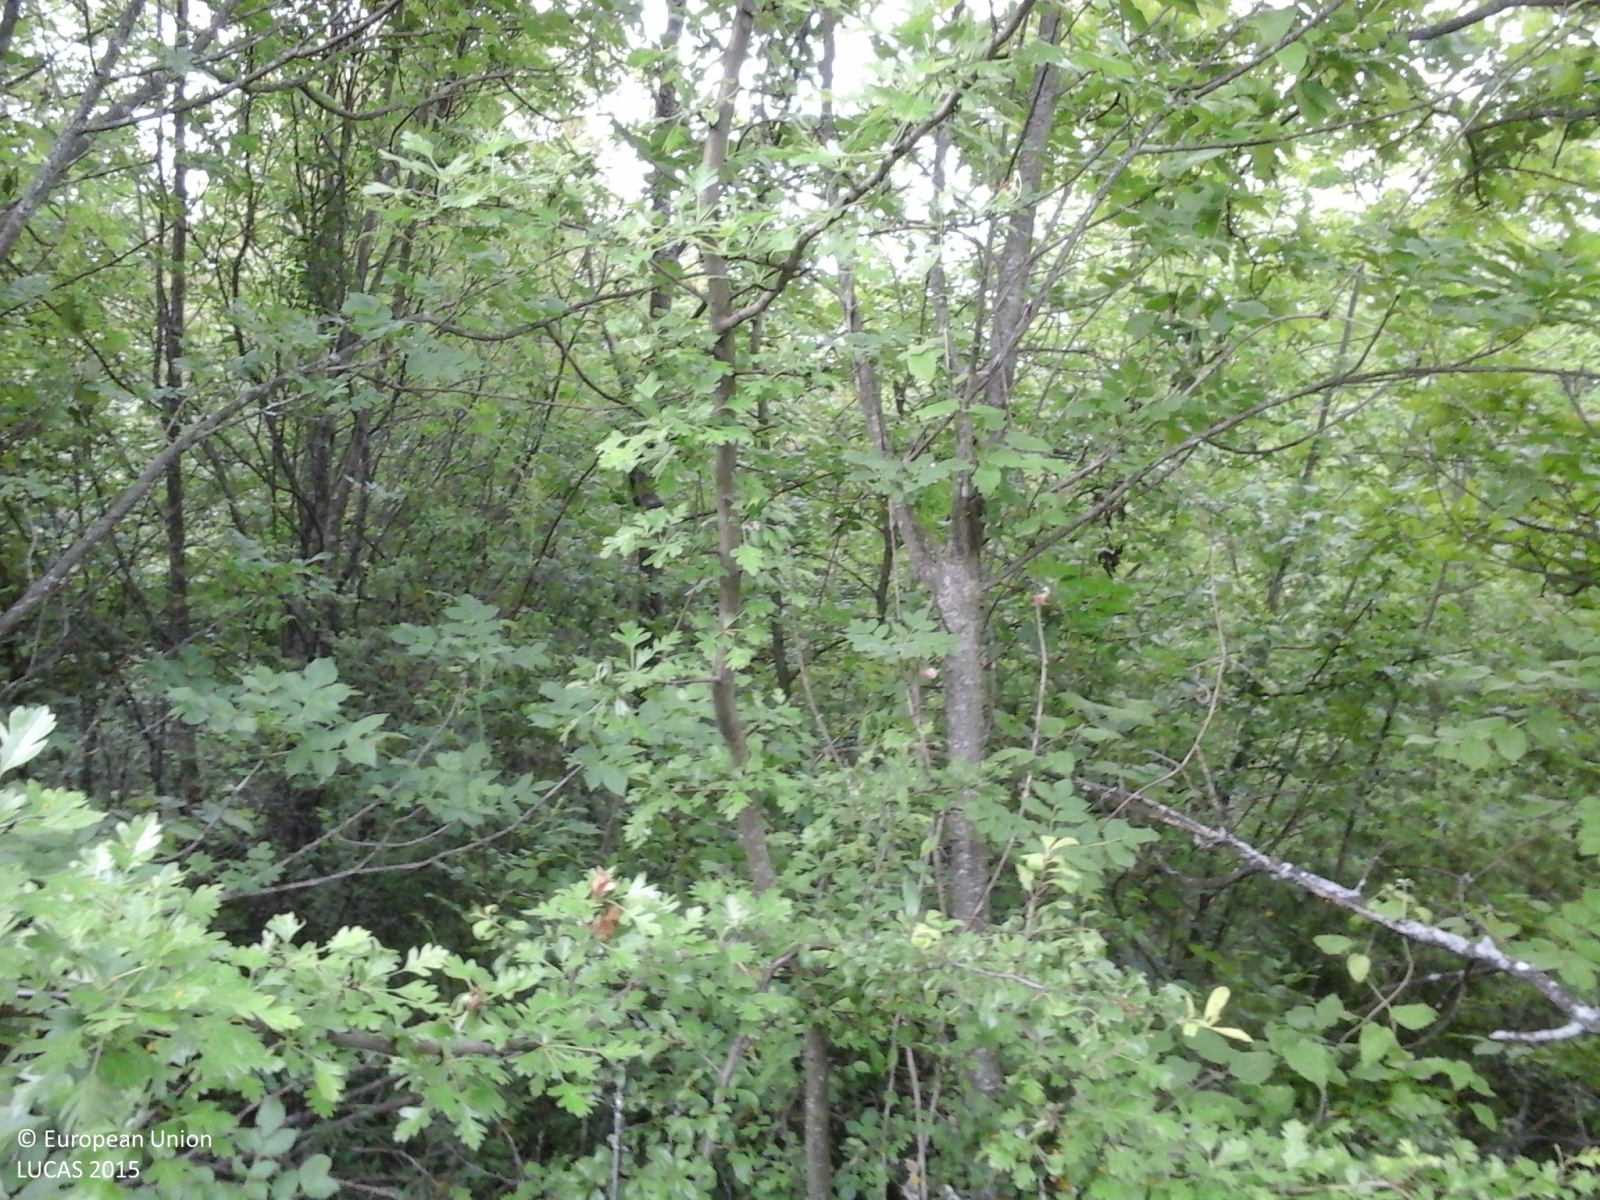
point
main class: Woodland
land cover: Broadleaved woodland
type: thermophilous deciduous forest
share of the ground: > 75 %
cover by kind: broadleaved forest trees 75 %, shrubs 25 %
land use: Forestry
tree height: > 5 m
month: May
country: IT
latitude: 44.5670
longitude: 10.0126
